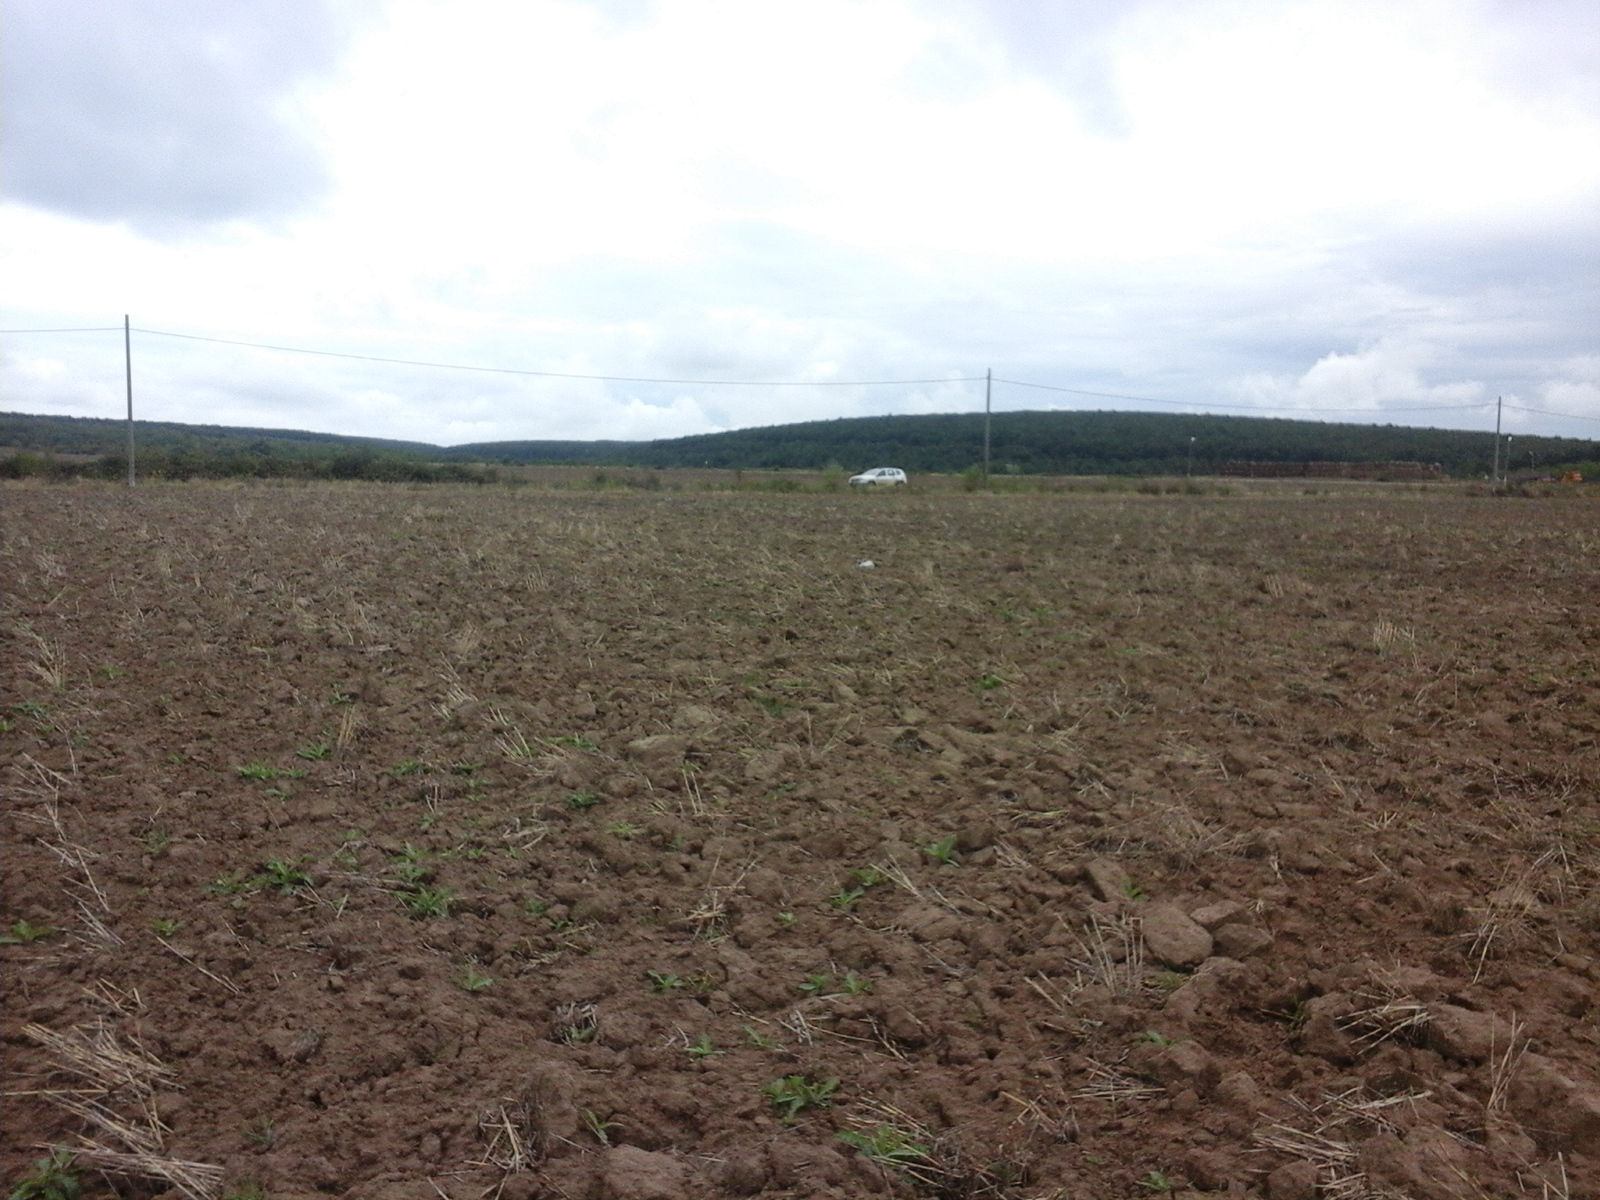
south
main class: Cropland
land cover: Common wheat
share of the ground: 10 - 25 %
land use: Agriculture (excluding fallow land and kitchen gardens)
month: September
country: RO
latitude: 46.6909
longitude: 22.0101
